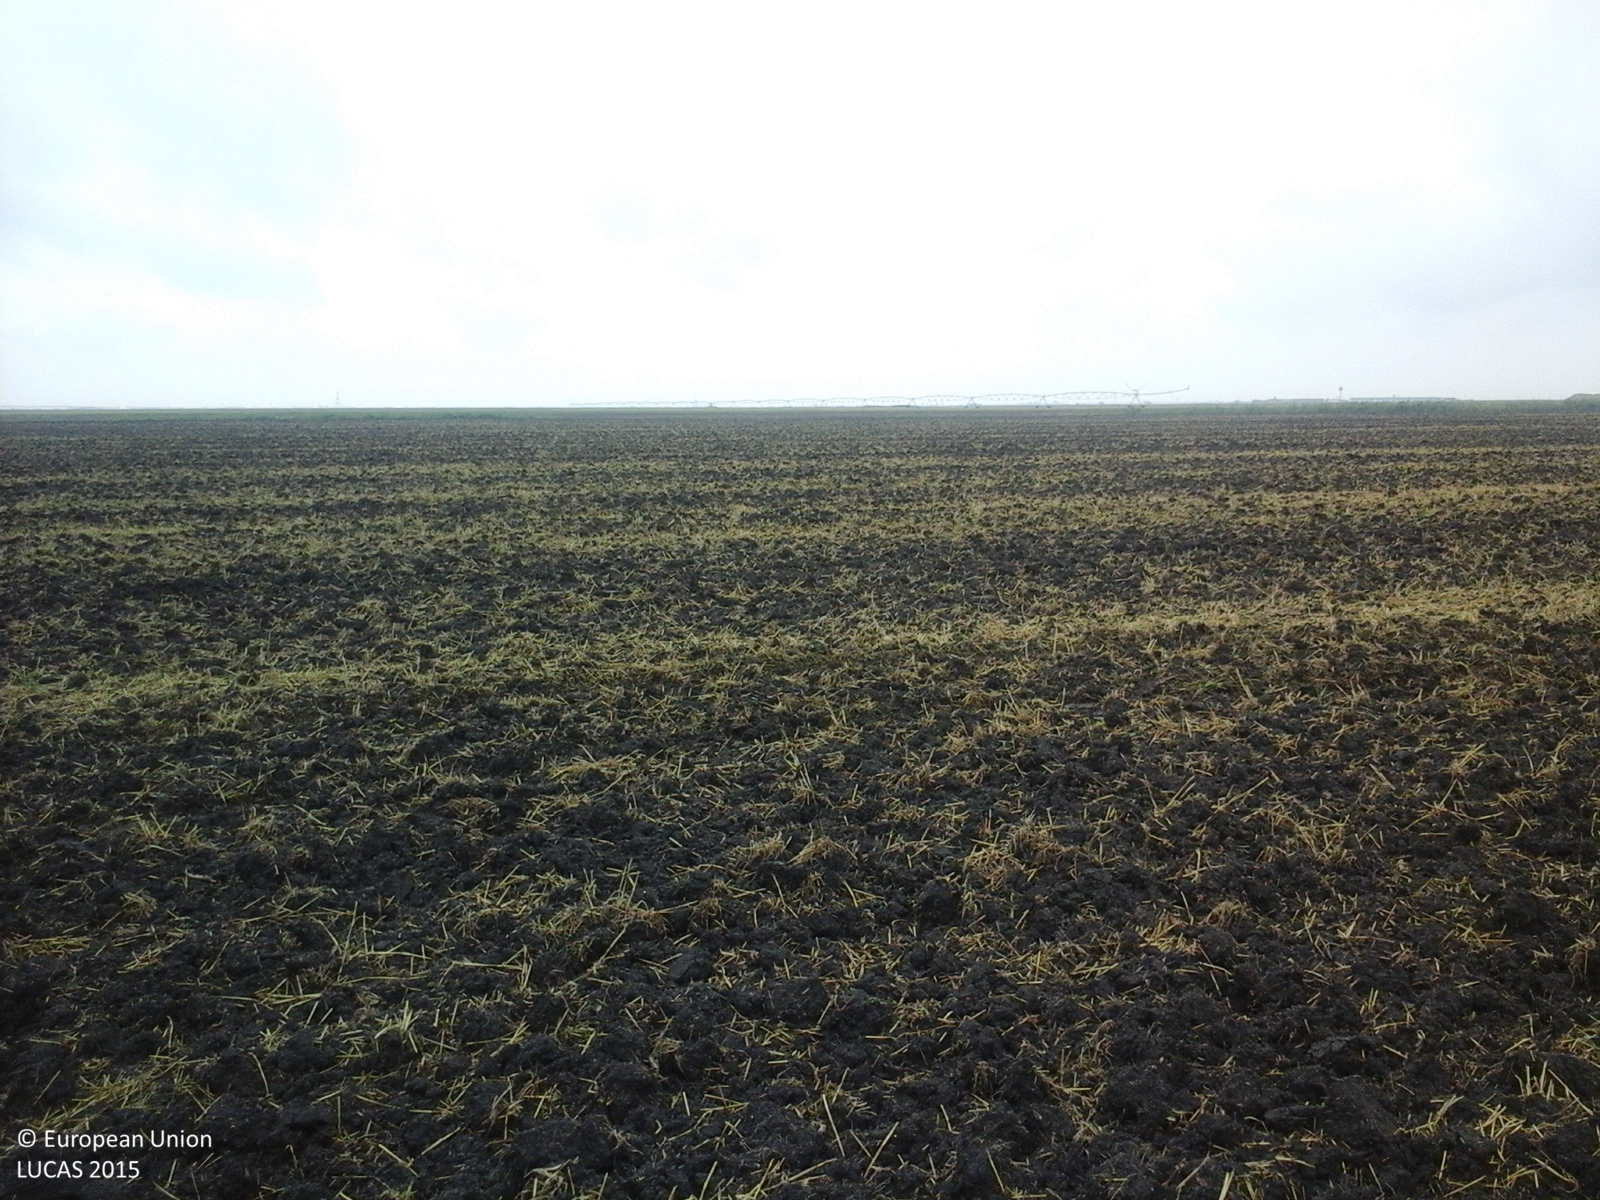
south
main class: Cropland
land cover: Common wheat
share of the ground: < 10 %
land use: Agriculture (excluding fallow land and kitchen gardens)
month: August
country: RO
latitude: 46.0019
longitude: 20.4443
